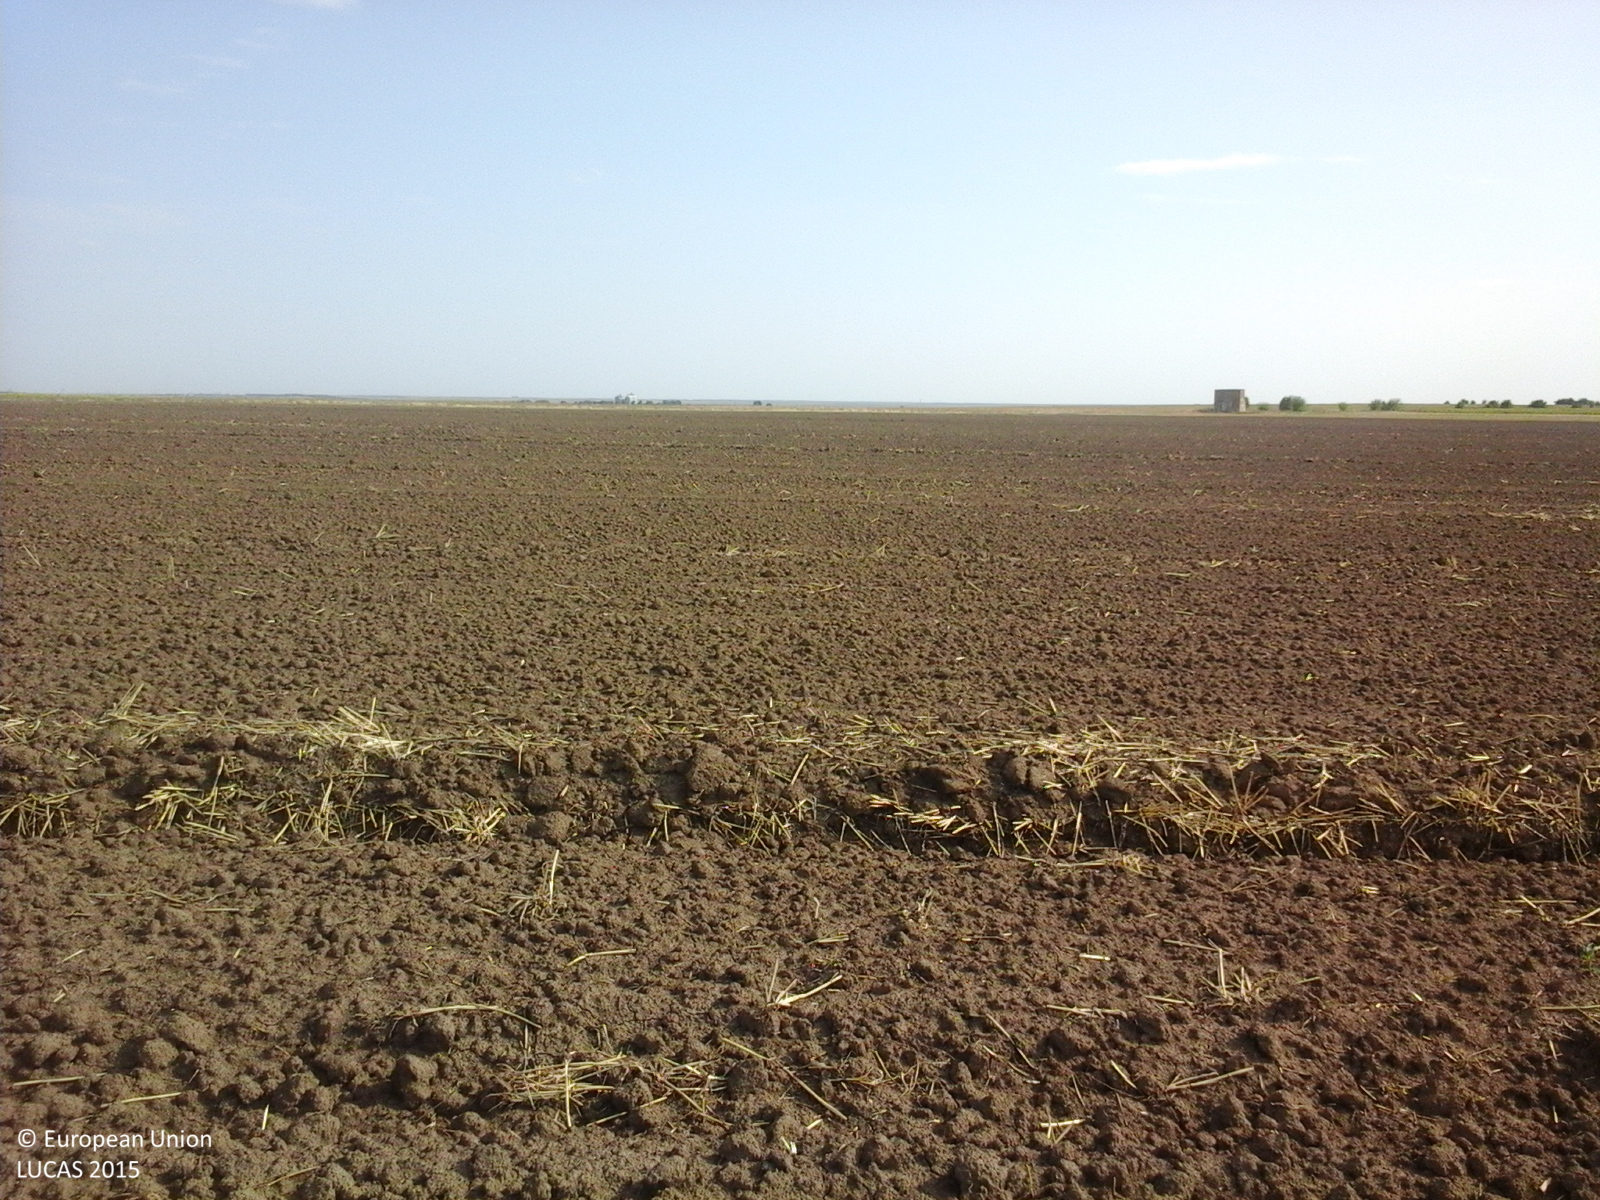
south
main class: Cropland
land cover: Common wheat
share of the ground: < 10 %
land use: Agriculture (excluding fallow land and kitchen gardens)
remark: Harvested field
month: August
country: RO
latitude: 44.0450
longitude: 28.3470
